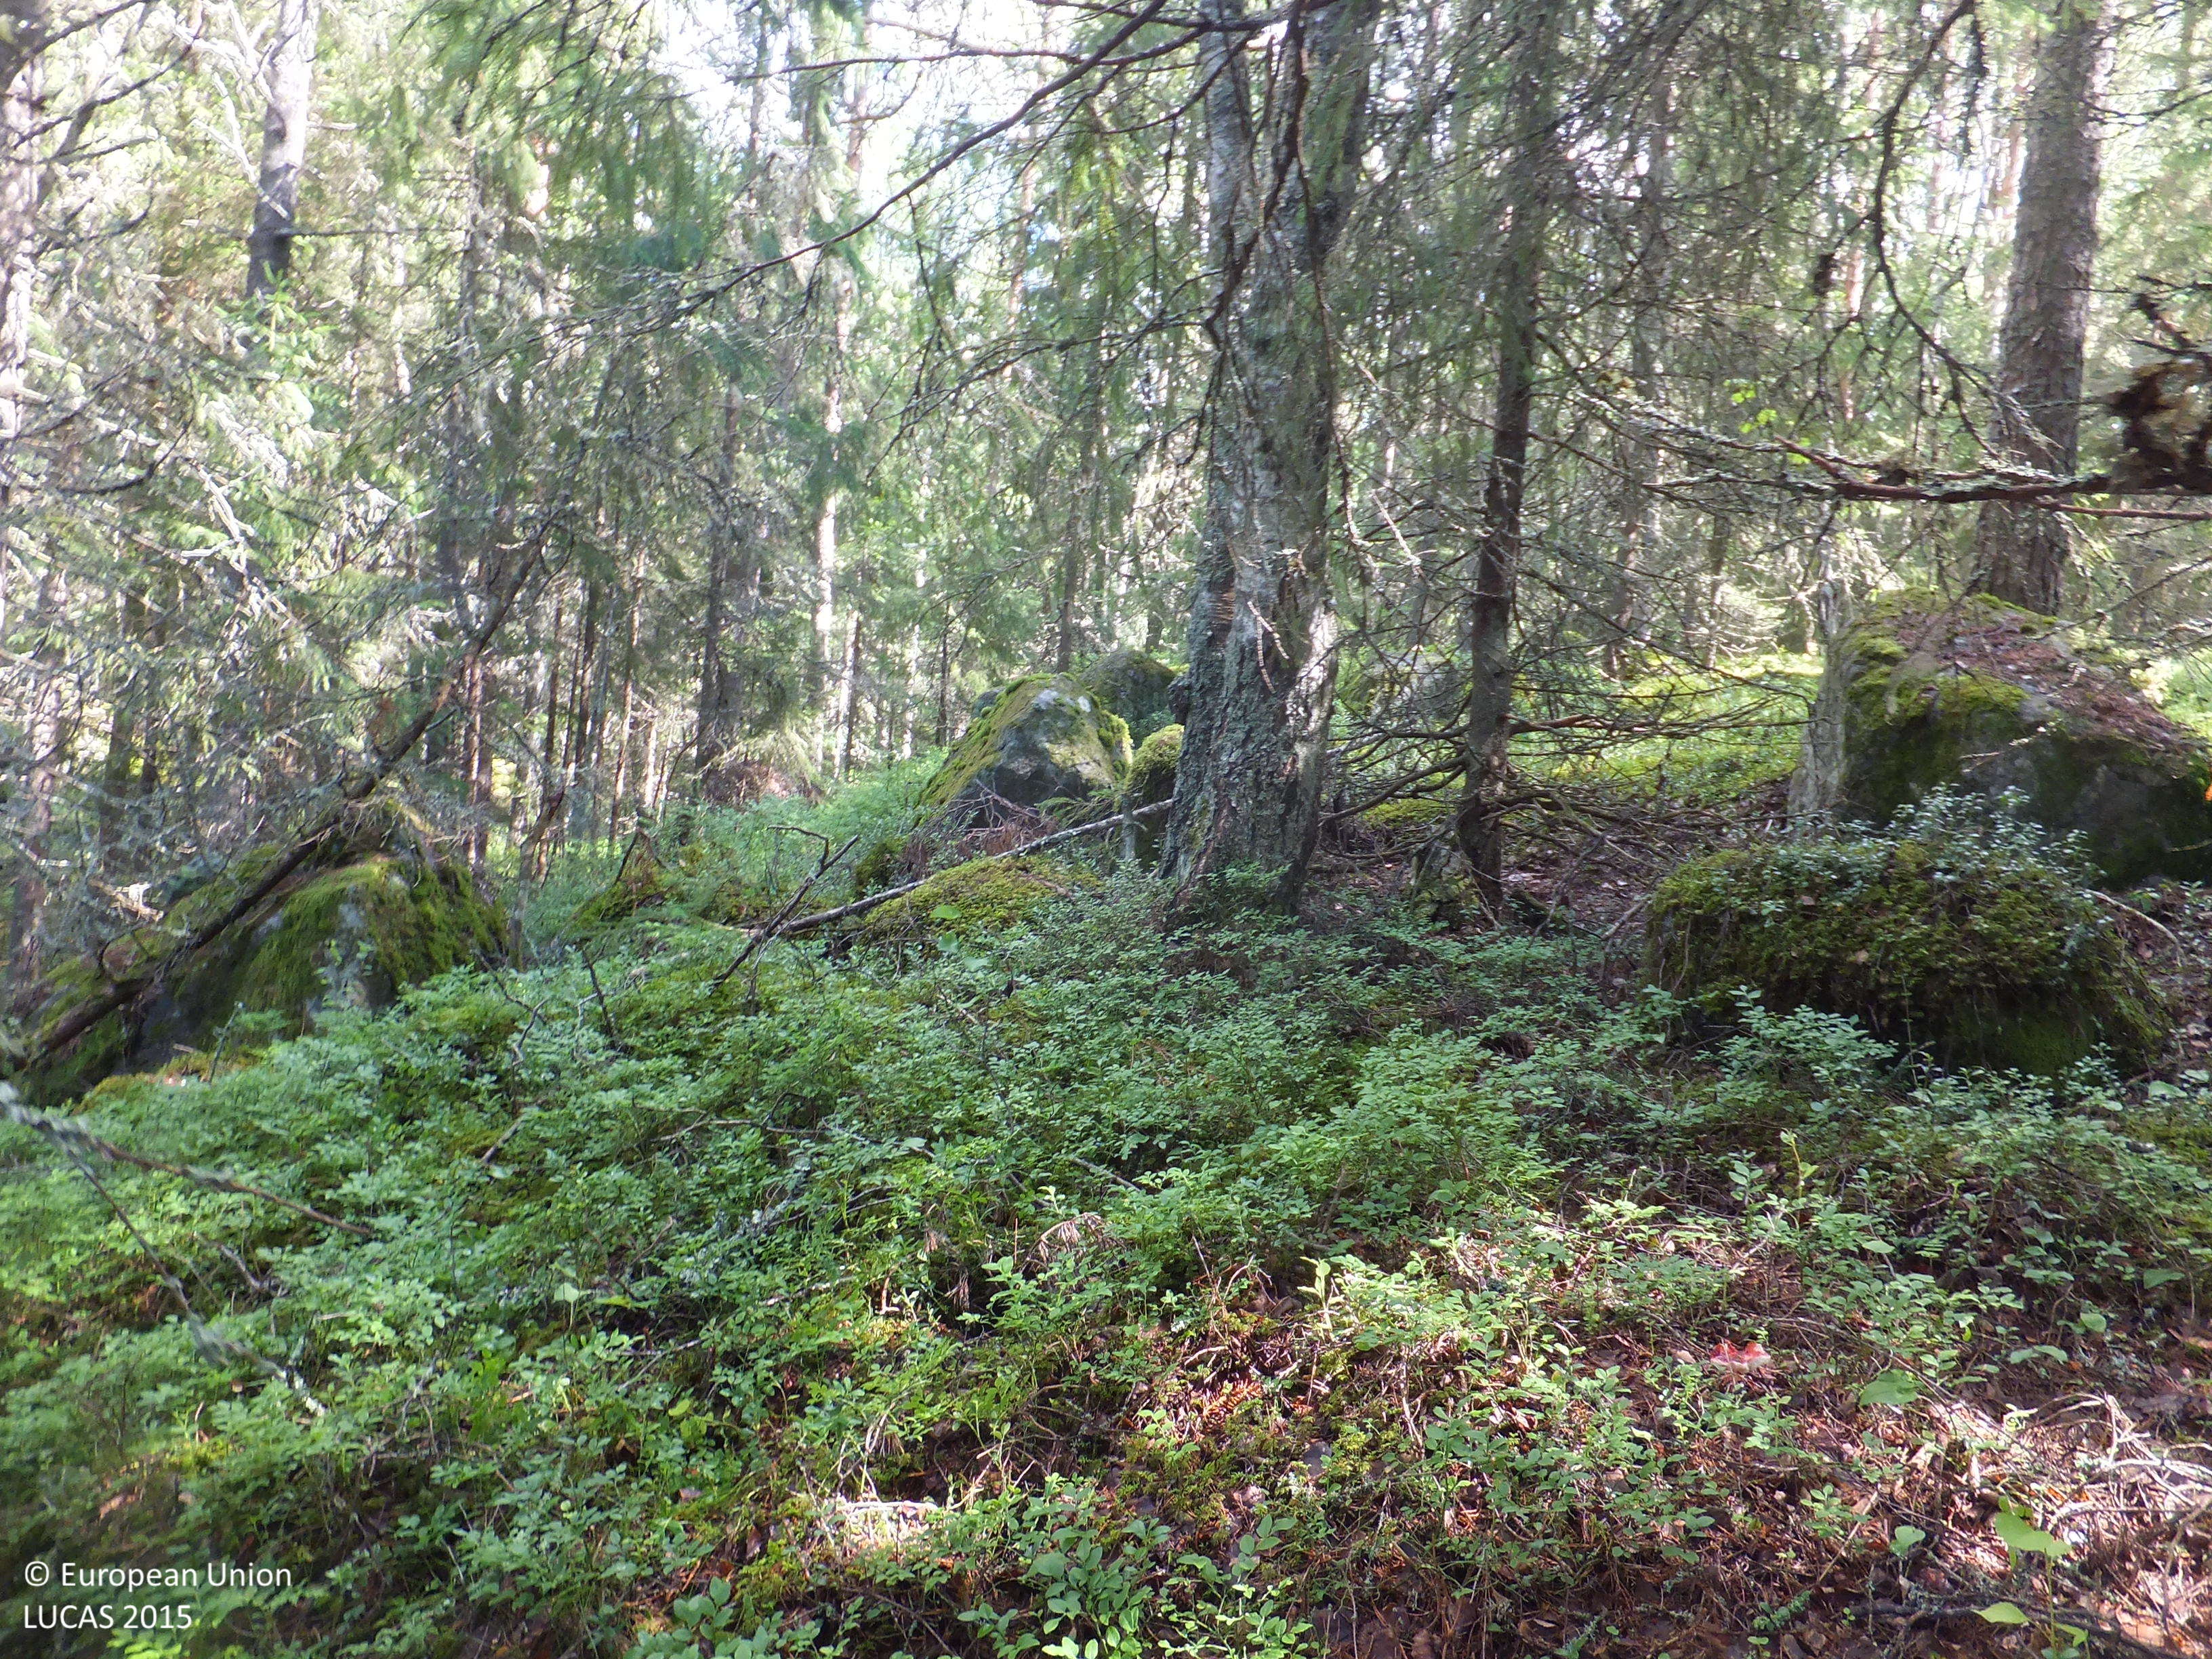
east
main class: Woodland
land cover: Other mixed woodland
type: boreal forest
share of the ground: > 75 %
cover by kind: coniferous forest trees 60 %, broadleaved forest trees 20 %, shrubs 10 %, herbaceous plants 5 %, lichens and mosses 5 %
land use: Forestry
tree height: > 5 m
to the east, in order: Other mixed woodland; Paved roads, cycling and walking lanes; Spruce dominated mixed woodland; Other mixed woodland
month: July
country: FI
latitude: 63.3160
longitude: 22.0387
